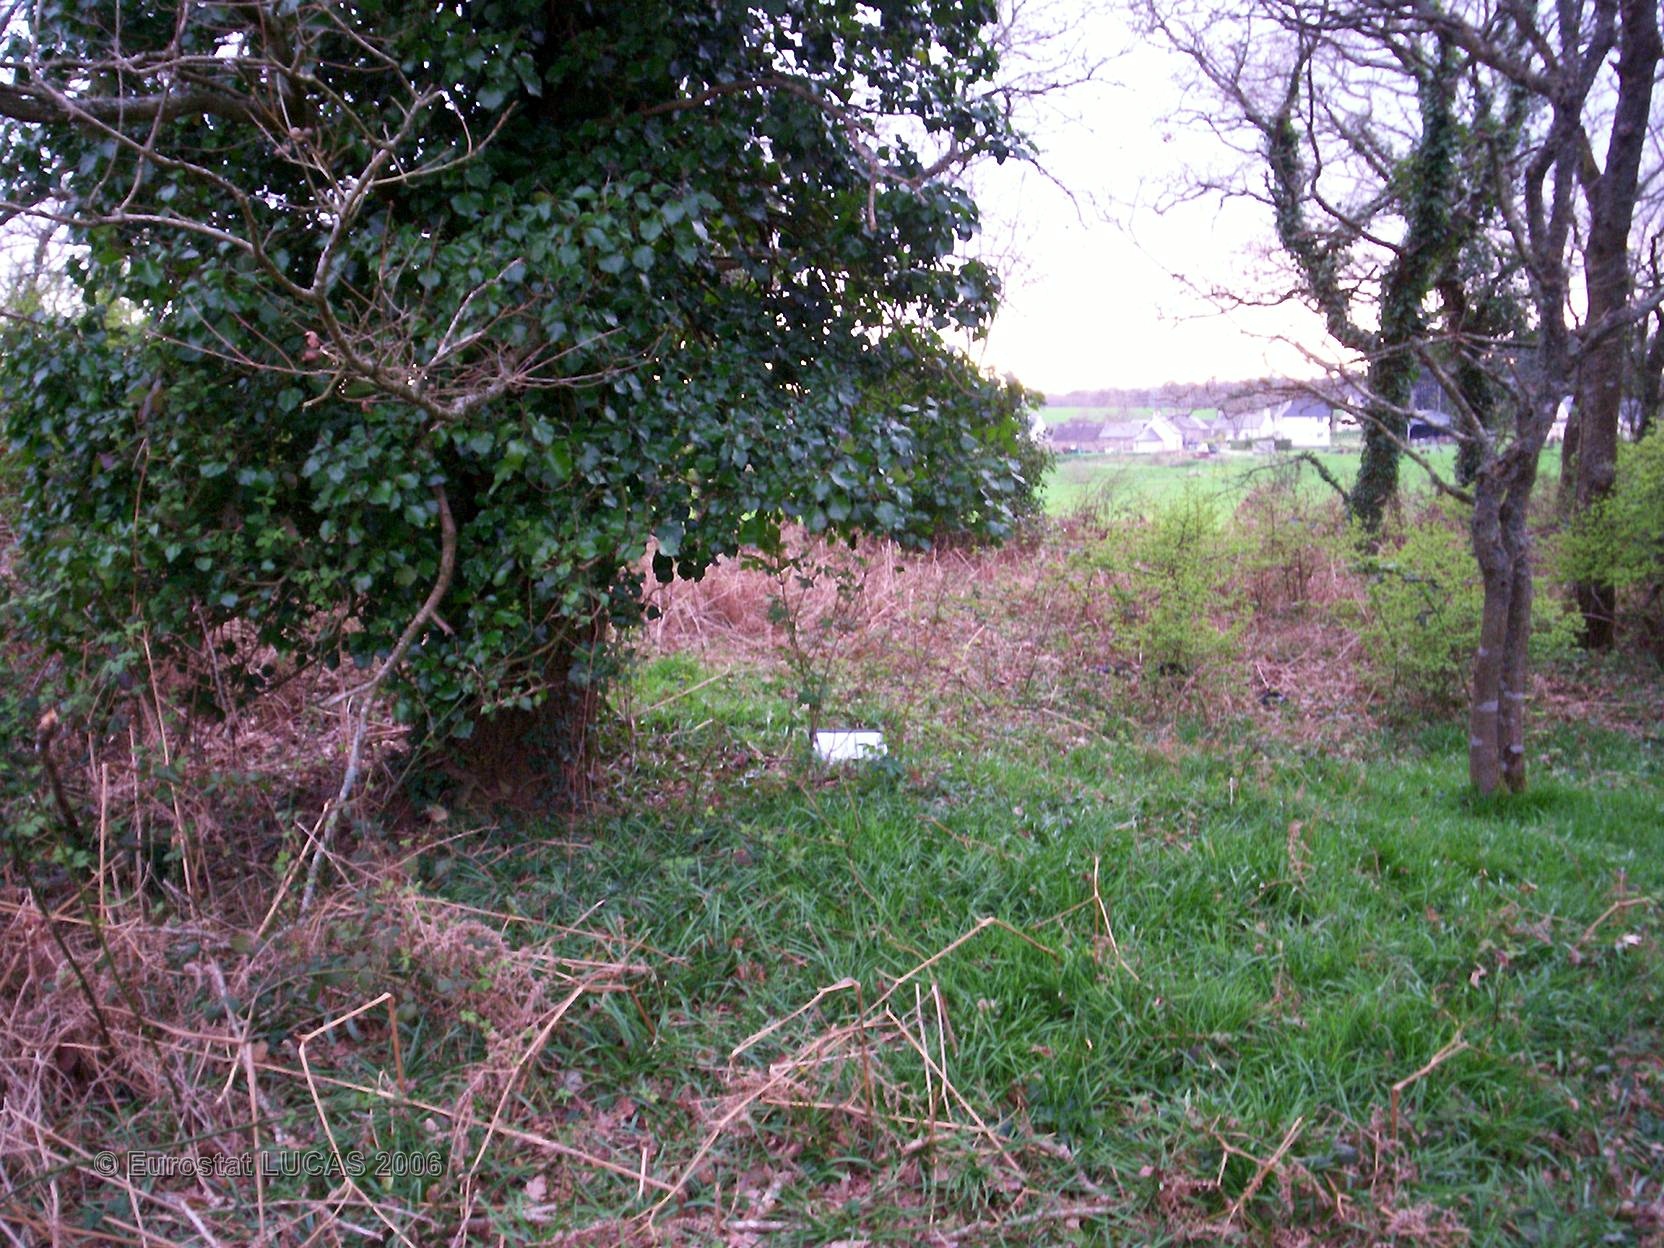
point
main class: Woodland
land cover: Broadleaved forest
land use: Forestry
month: April
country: FR
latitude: 47.7942
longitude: -3.4646
